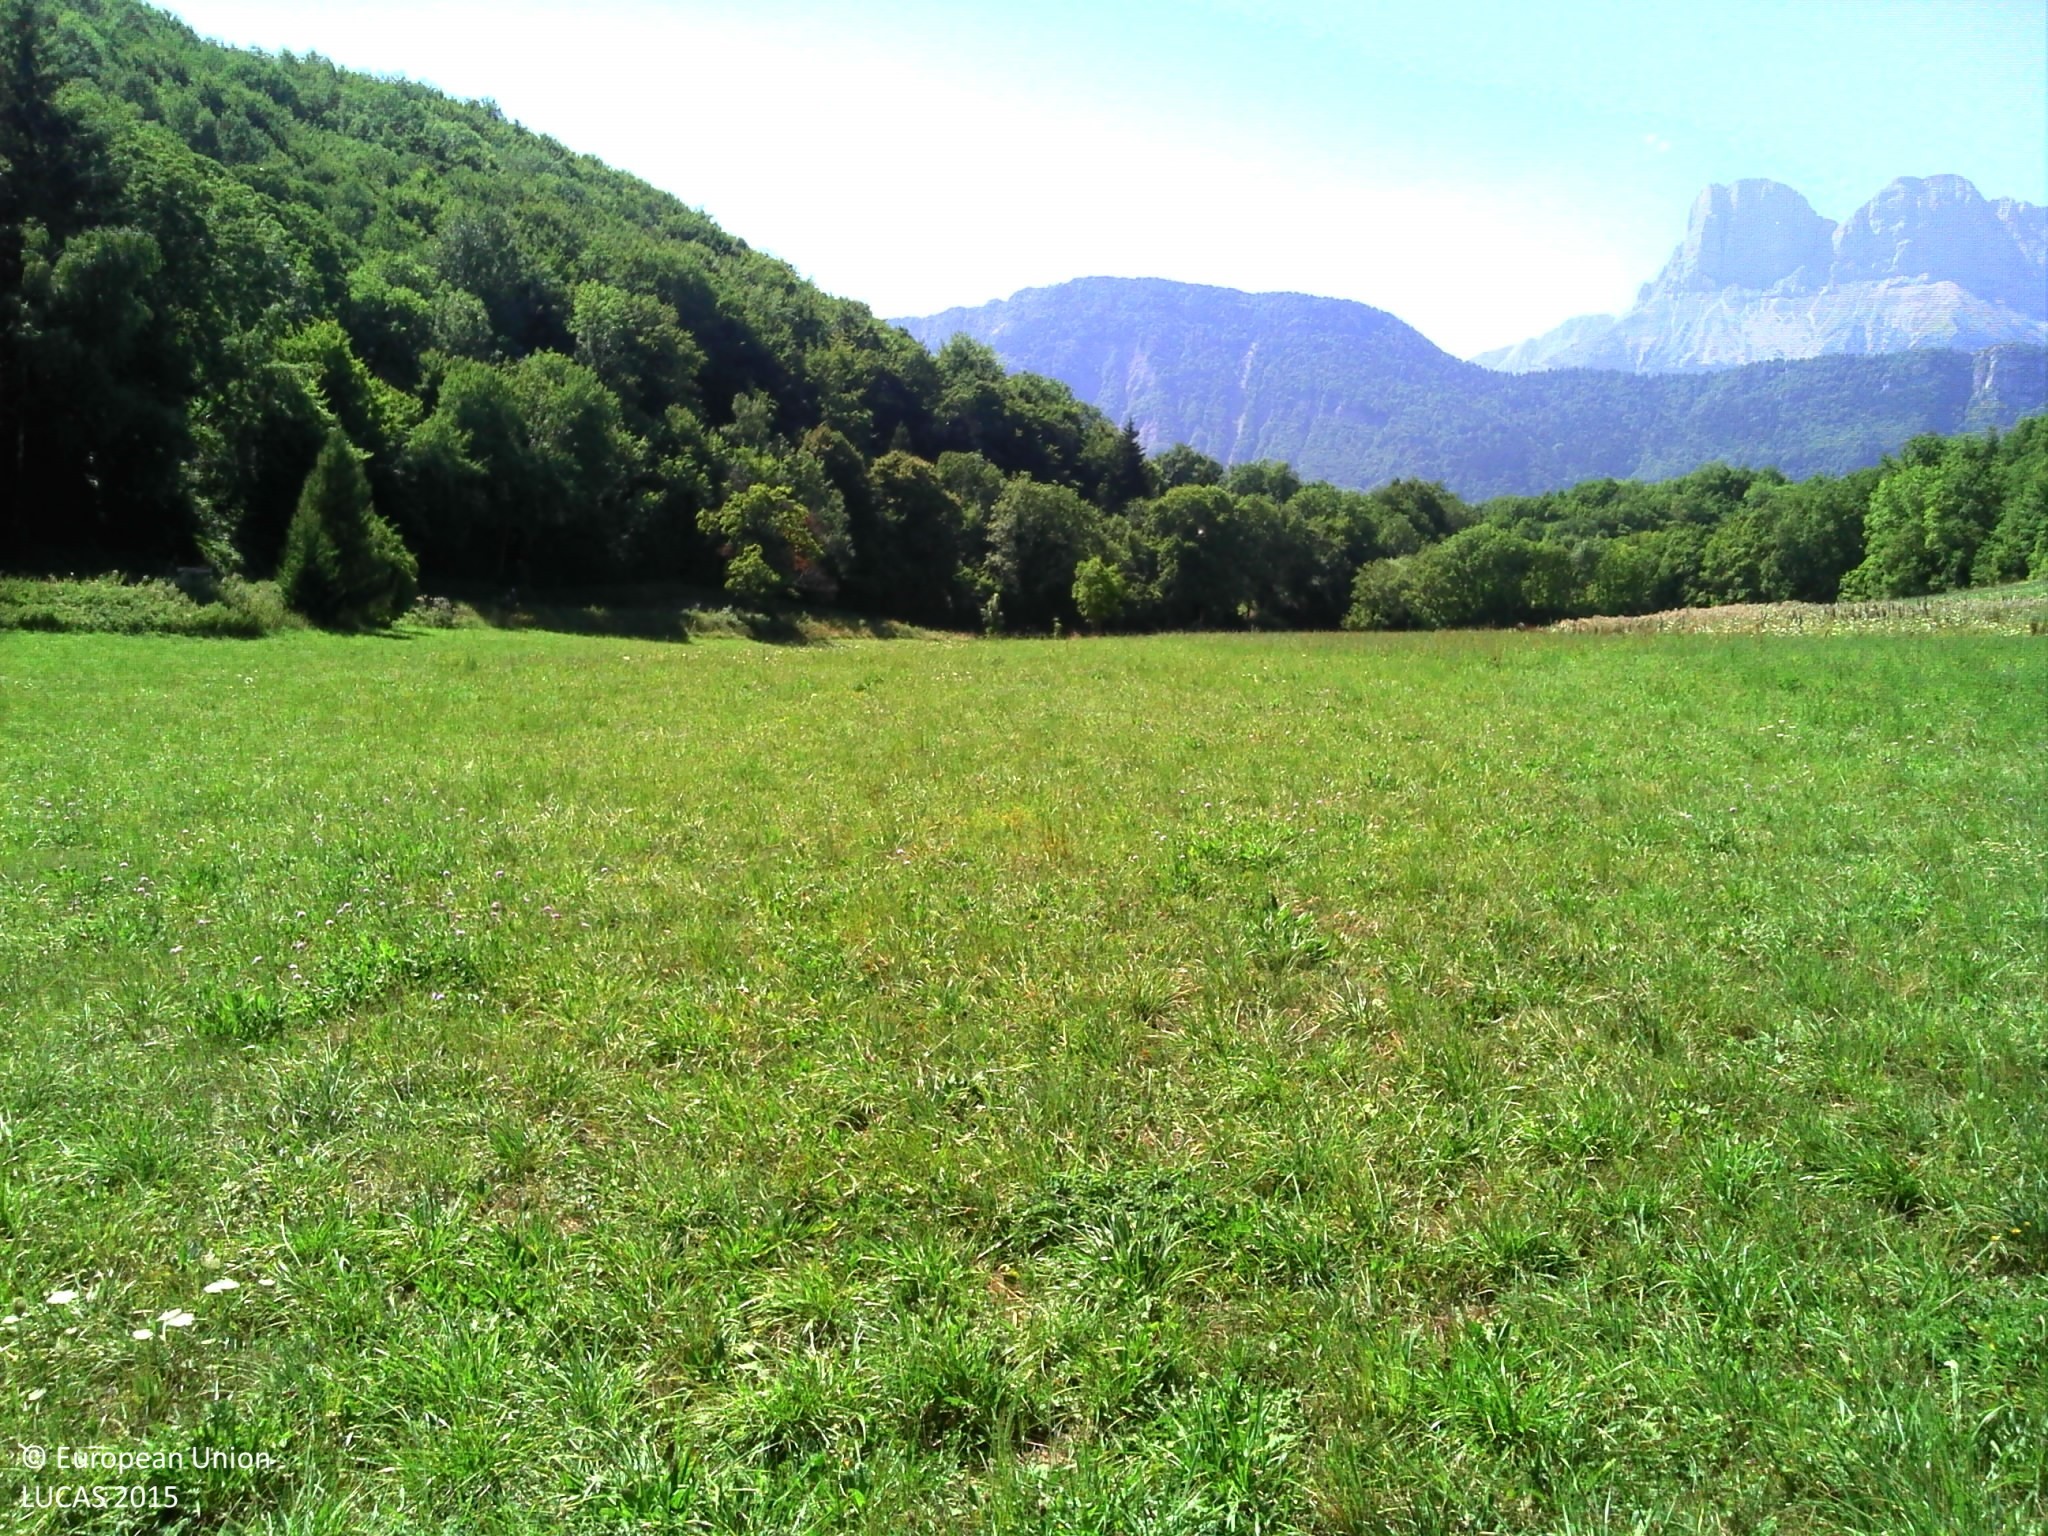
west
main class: Grassland
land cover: Grassland without tree/shrub cover
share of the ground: > 75 %
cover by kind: herbaceous plants 100 %
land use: Agriculture (excluding fallow land and kitchen gardens)
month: August
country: FR
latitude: 44.9819
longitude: 5.6559
